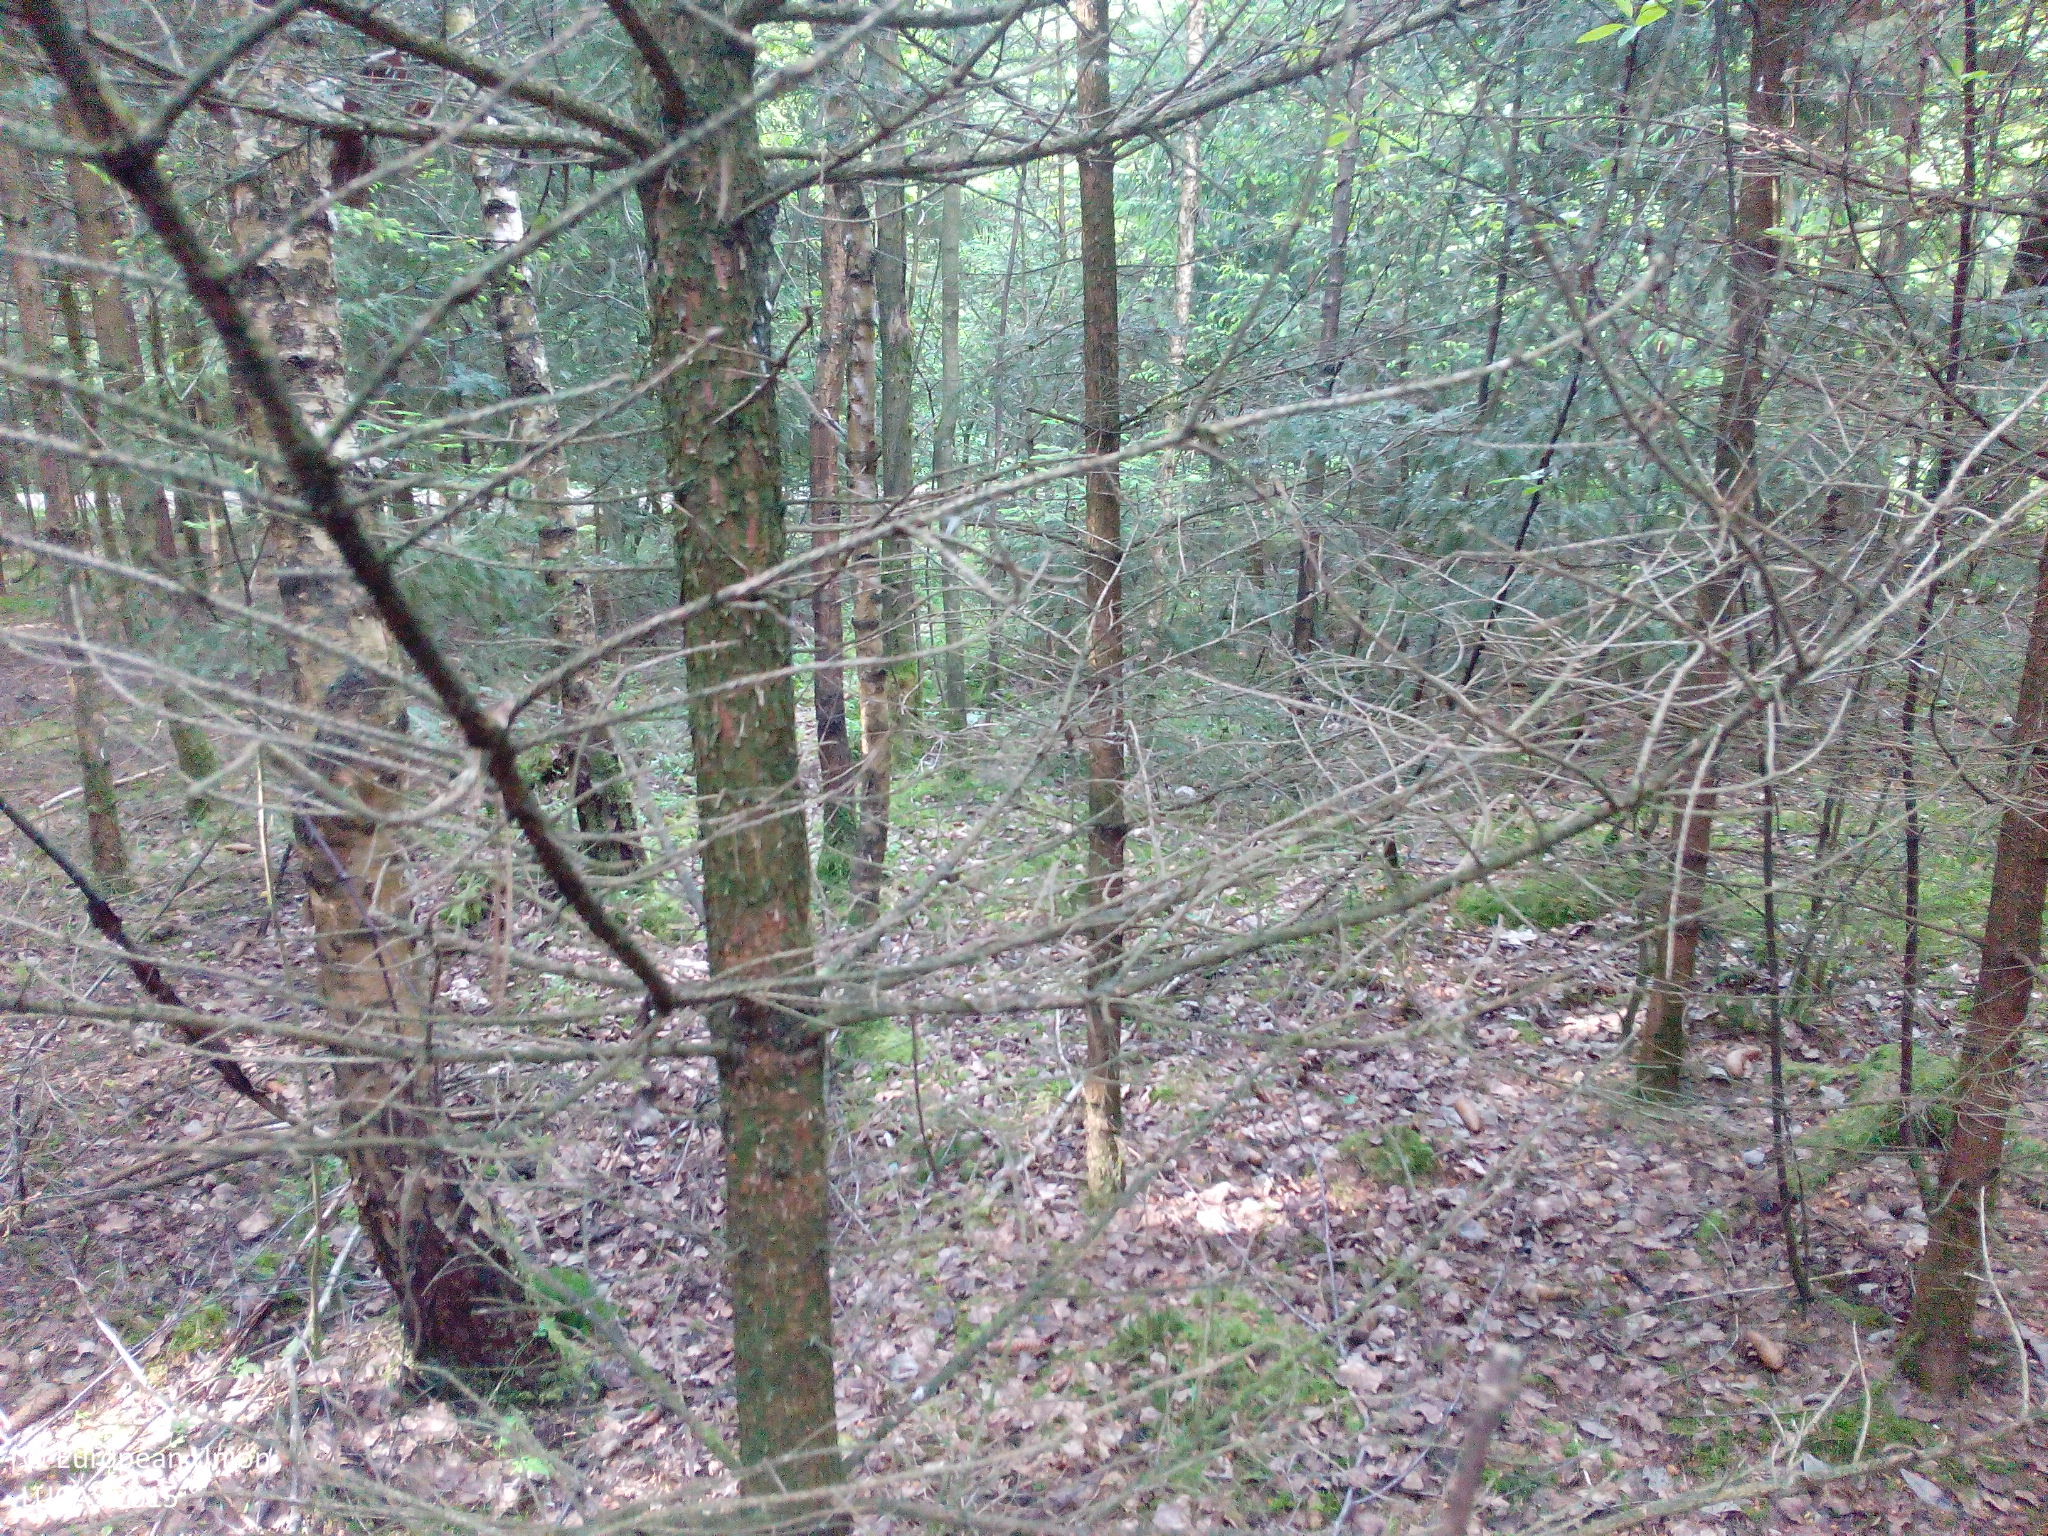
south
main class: Woodland
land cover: Spruce dominated coniferous woodland
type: hemiboreal forest and nemoral coniferous forest and mixed broadleaved-coniferous forest
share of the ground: > 75 %
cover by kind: coniferous forest trees 90 %, broadleaved forest trees 10 %
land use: Forestry
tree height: > 5 m
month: May
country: DE
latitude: 49.3376
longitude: 10.5640
